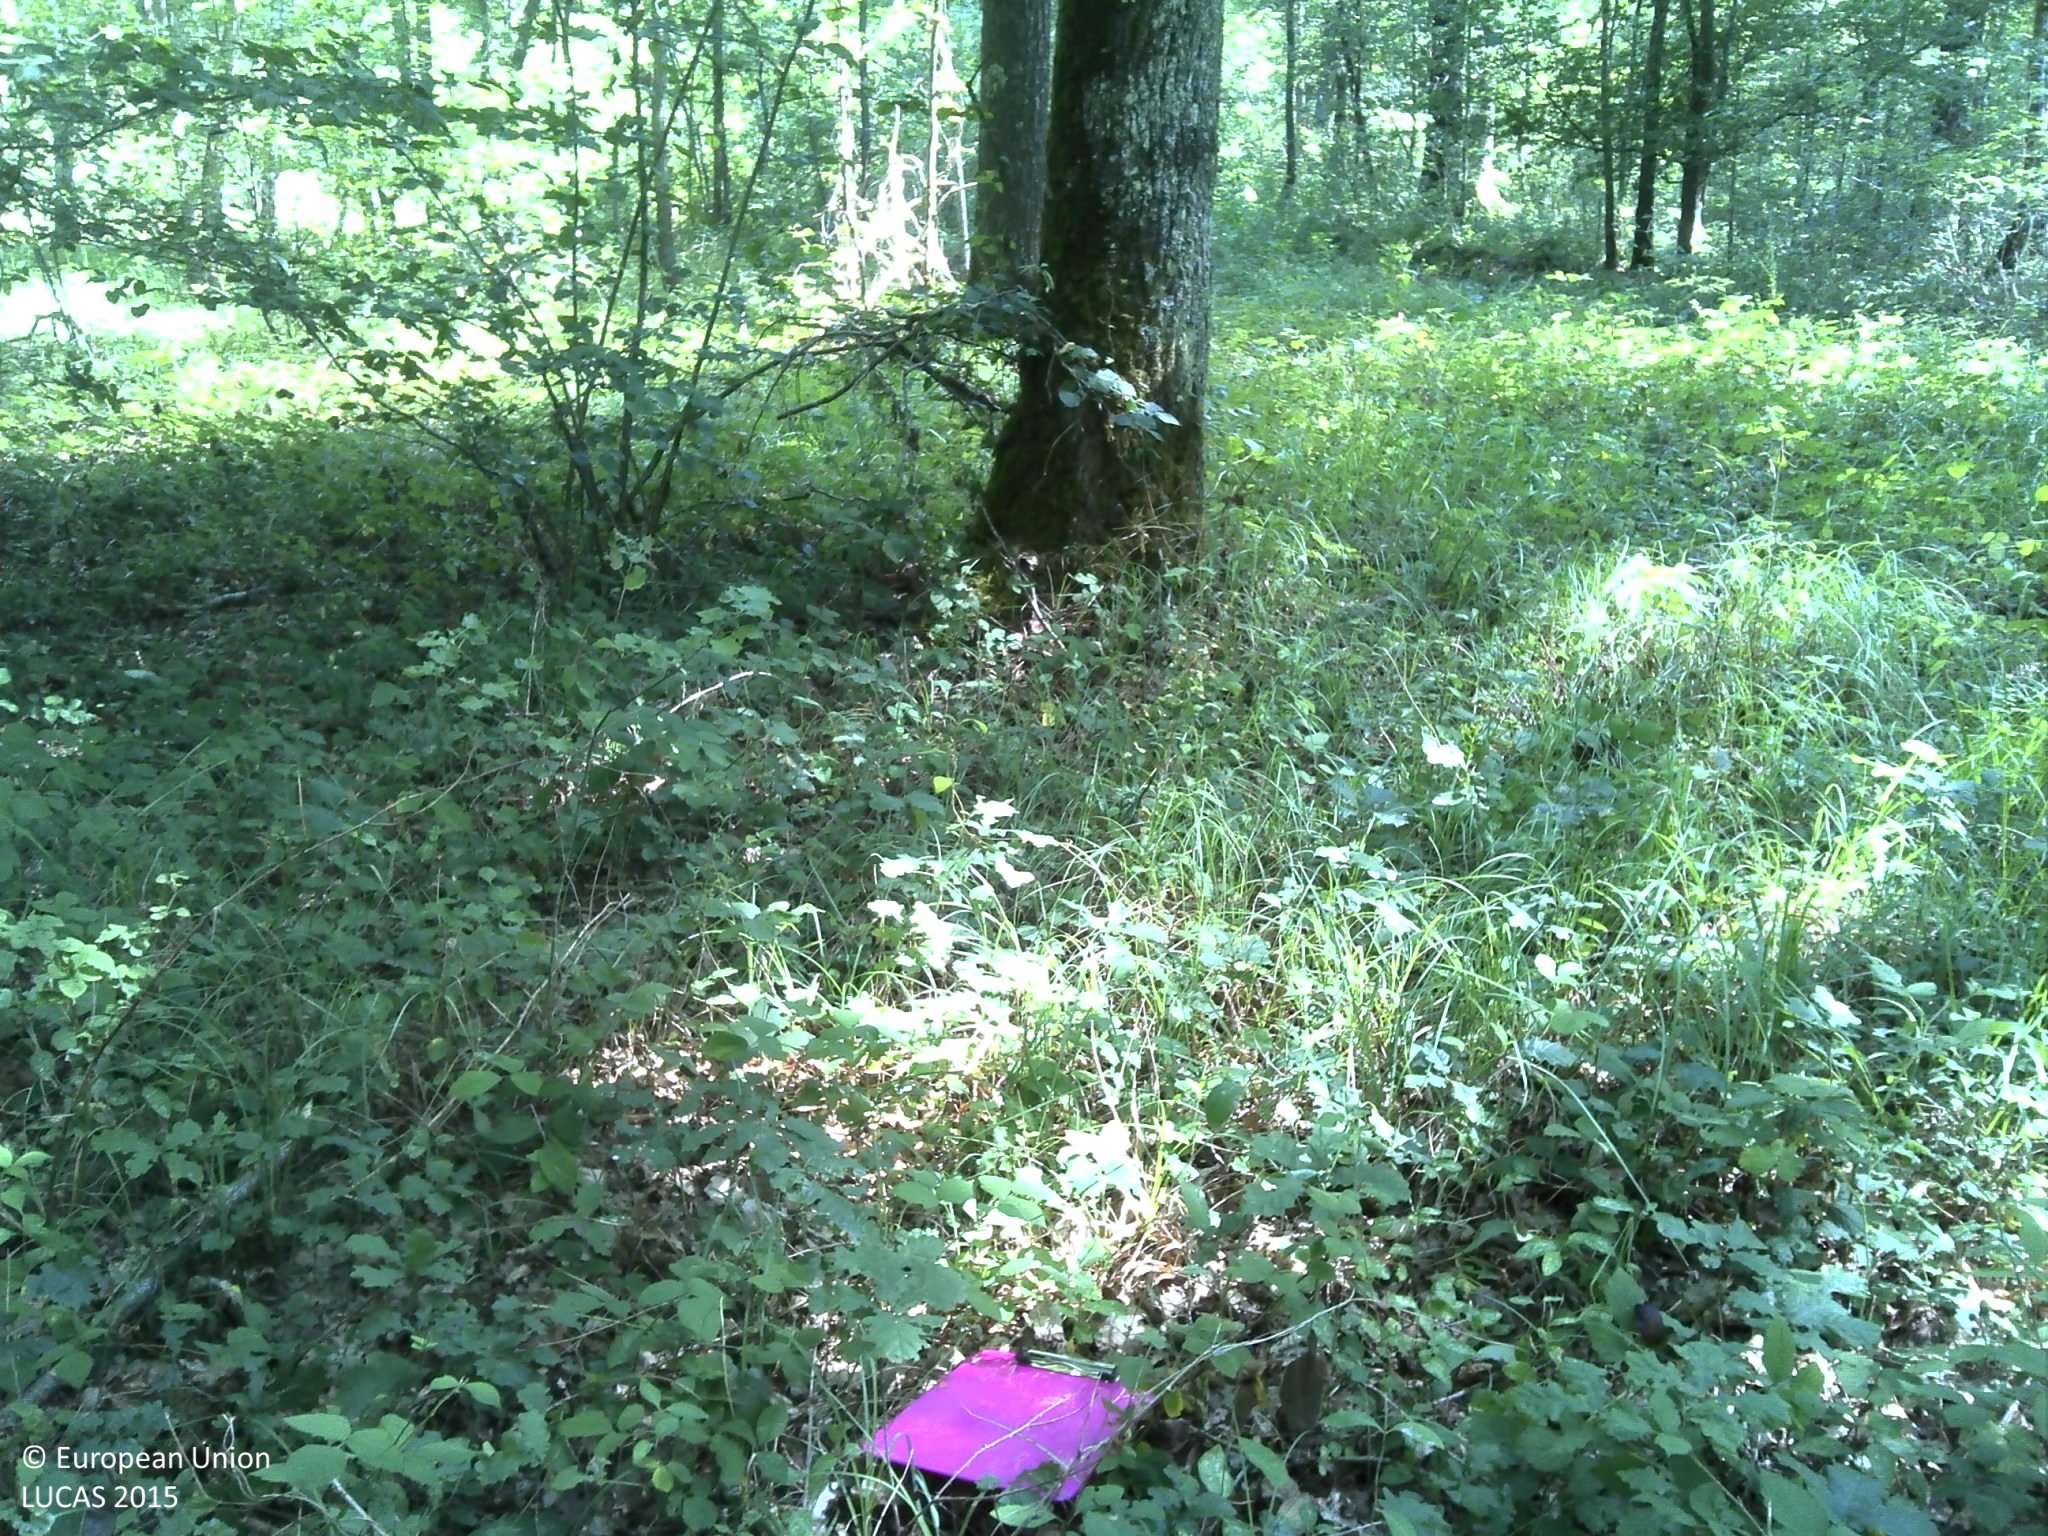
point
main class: Woodland
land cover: Broadleaved woodland
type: mesophytic deciduous forest
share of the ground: > 75 %
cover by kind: broadleaved forest trees 80 %, shrubs 10 %, herbaceous plants 10 %
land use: Forestry
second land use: Amenities, museums, leisure
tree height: > 5 m
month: August
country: FR
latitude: 48.6273
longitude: 1.8583
